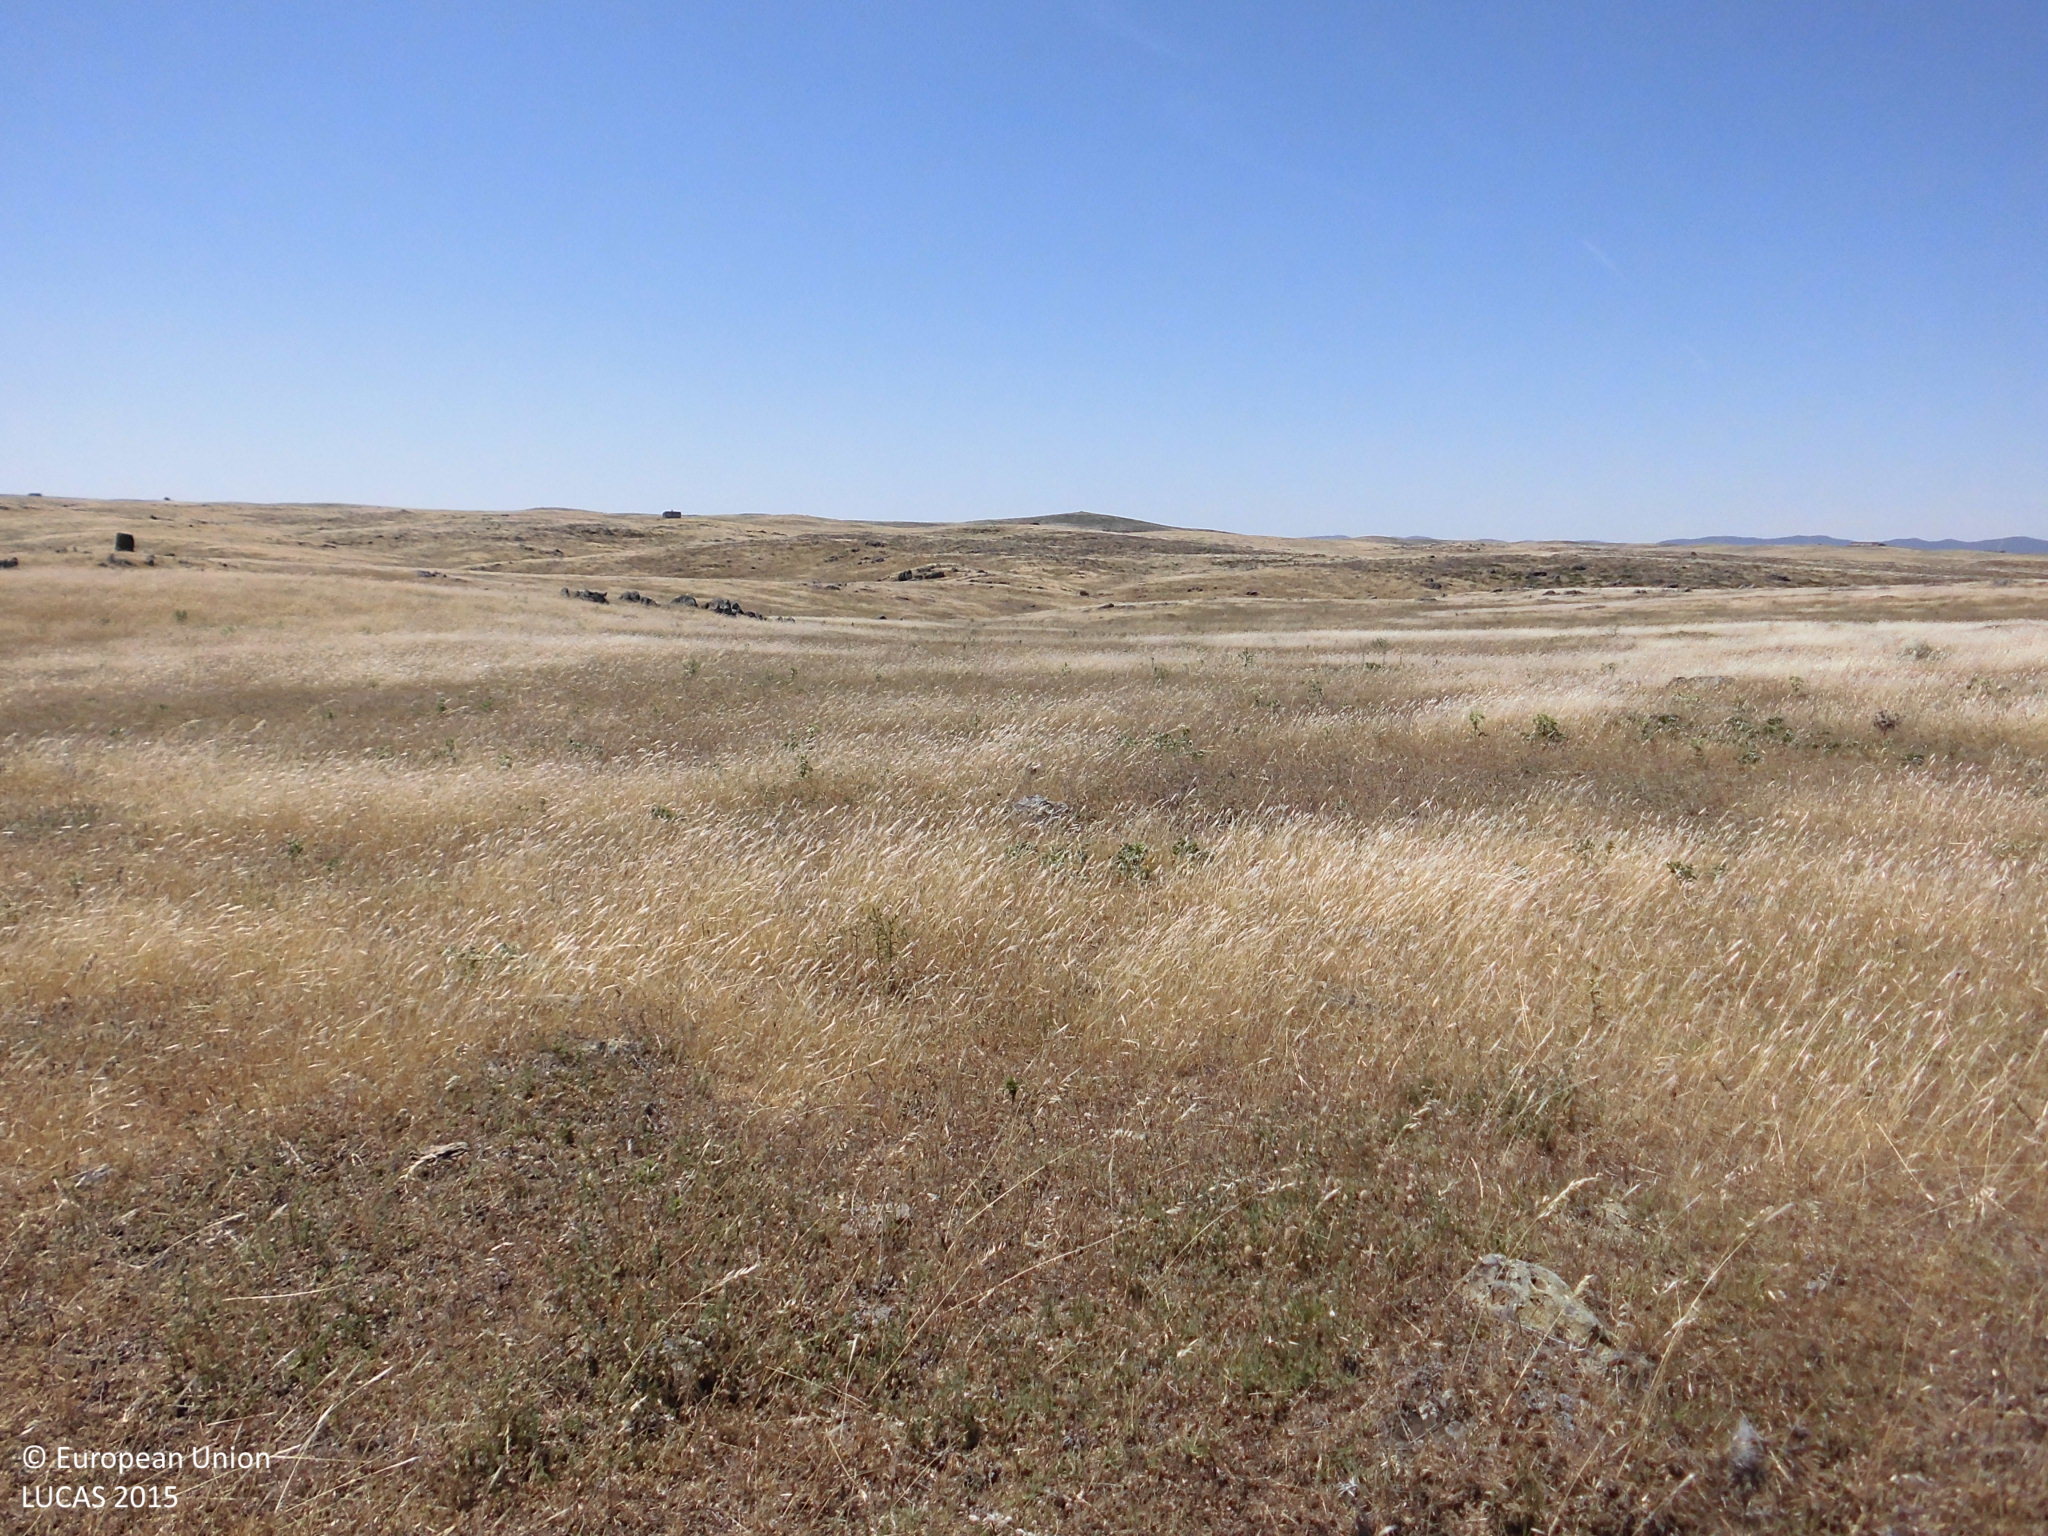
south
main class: Grassland
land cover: Grassland without tree/shrub cover
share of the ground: > 75 %
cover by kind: herbaceous plants 100 %
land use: Agriculture (excluding fallow land and kitchen gardens)
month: May
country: ES
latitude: 39.5716
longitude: -6.8543
